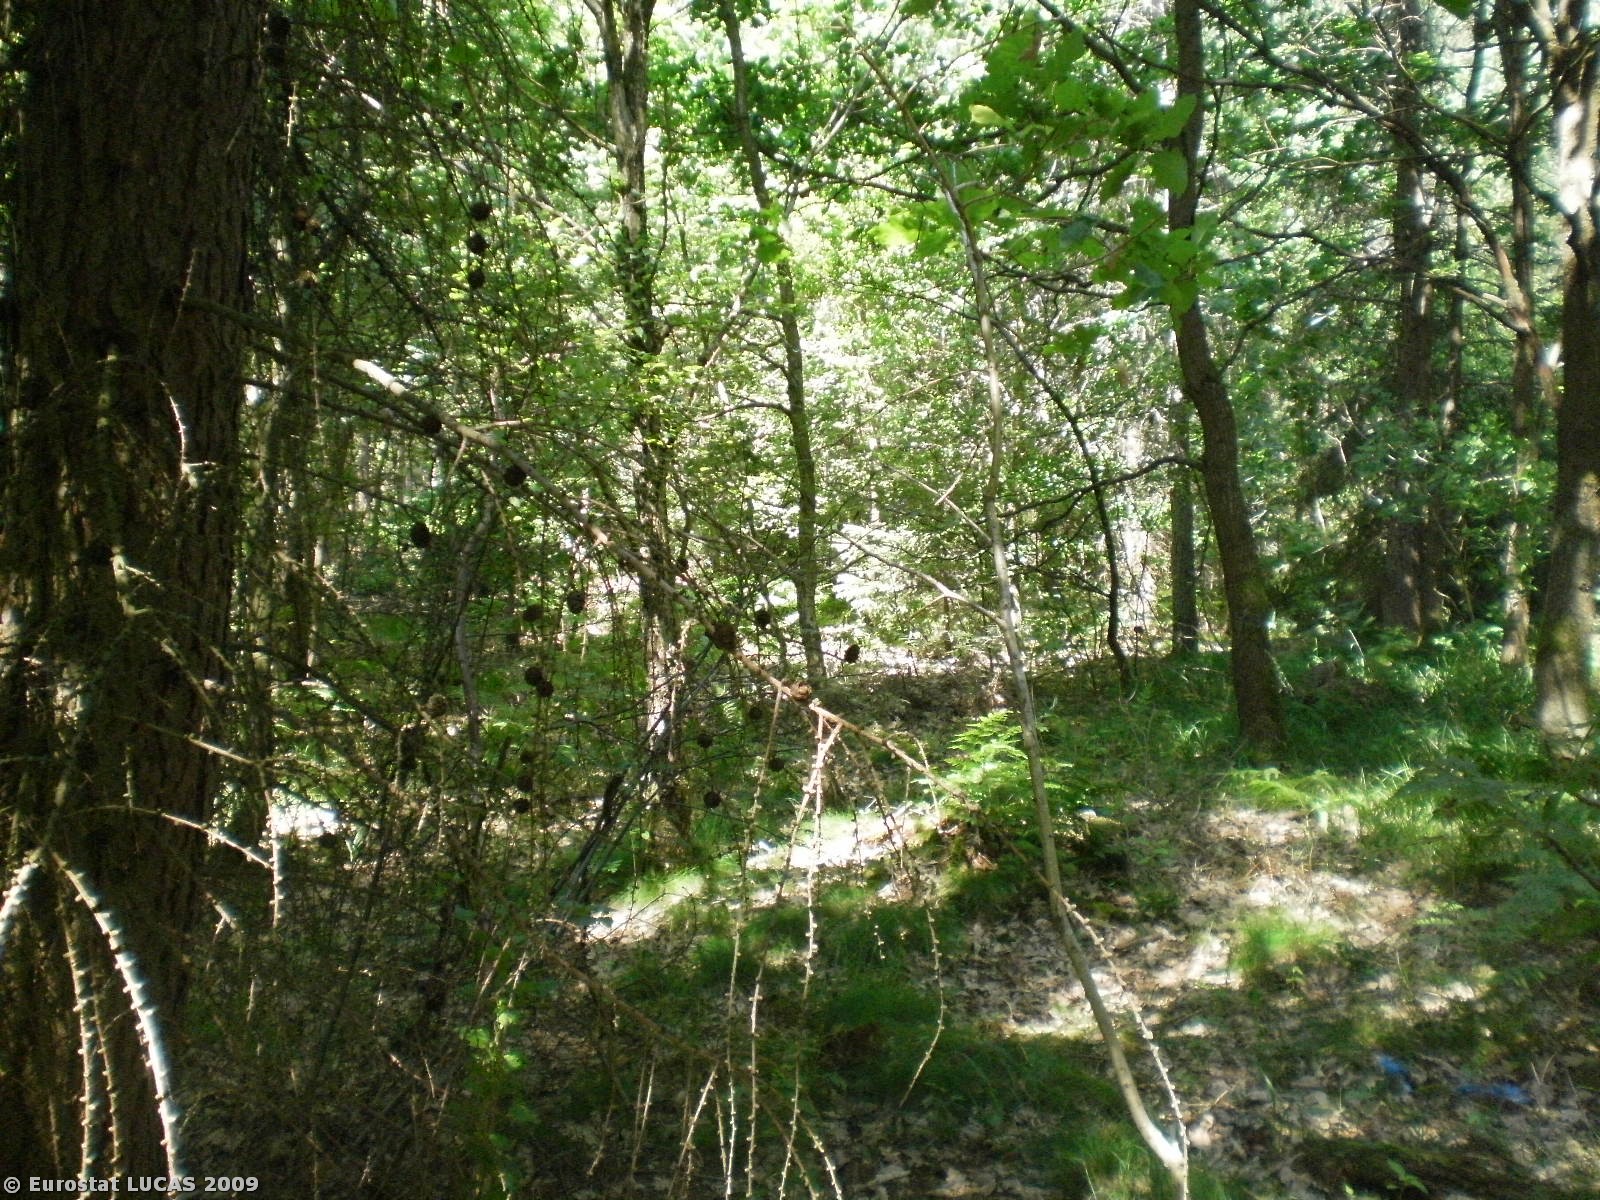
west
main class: Woodland
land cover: Mixed woodland
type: hemiboreal forest and nemoral coniferous forest and mixed broadleaved-coniferous forest
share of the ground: > 75 %
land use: Forestry
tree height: > 5 m
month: June
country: PL
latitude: 54.4628
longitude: 17.3066
